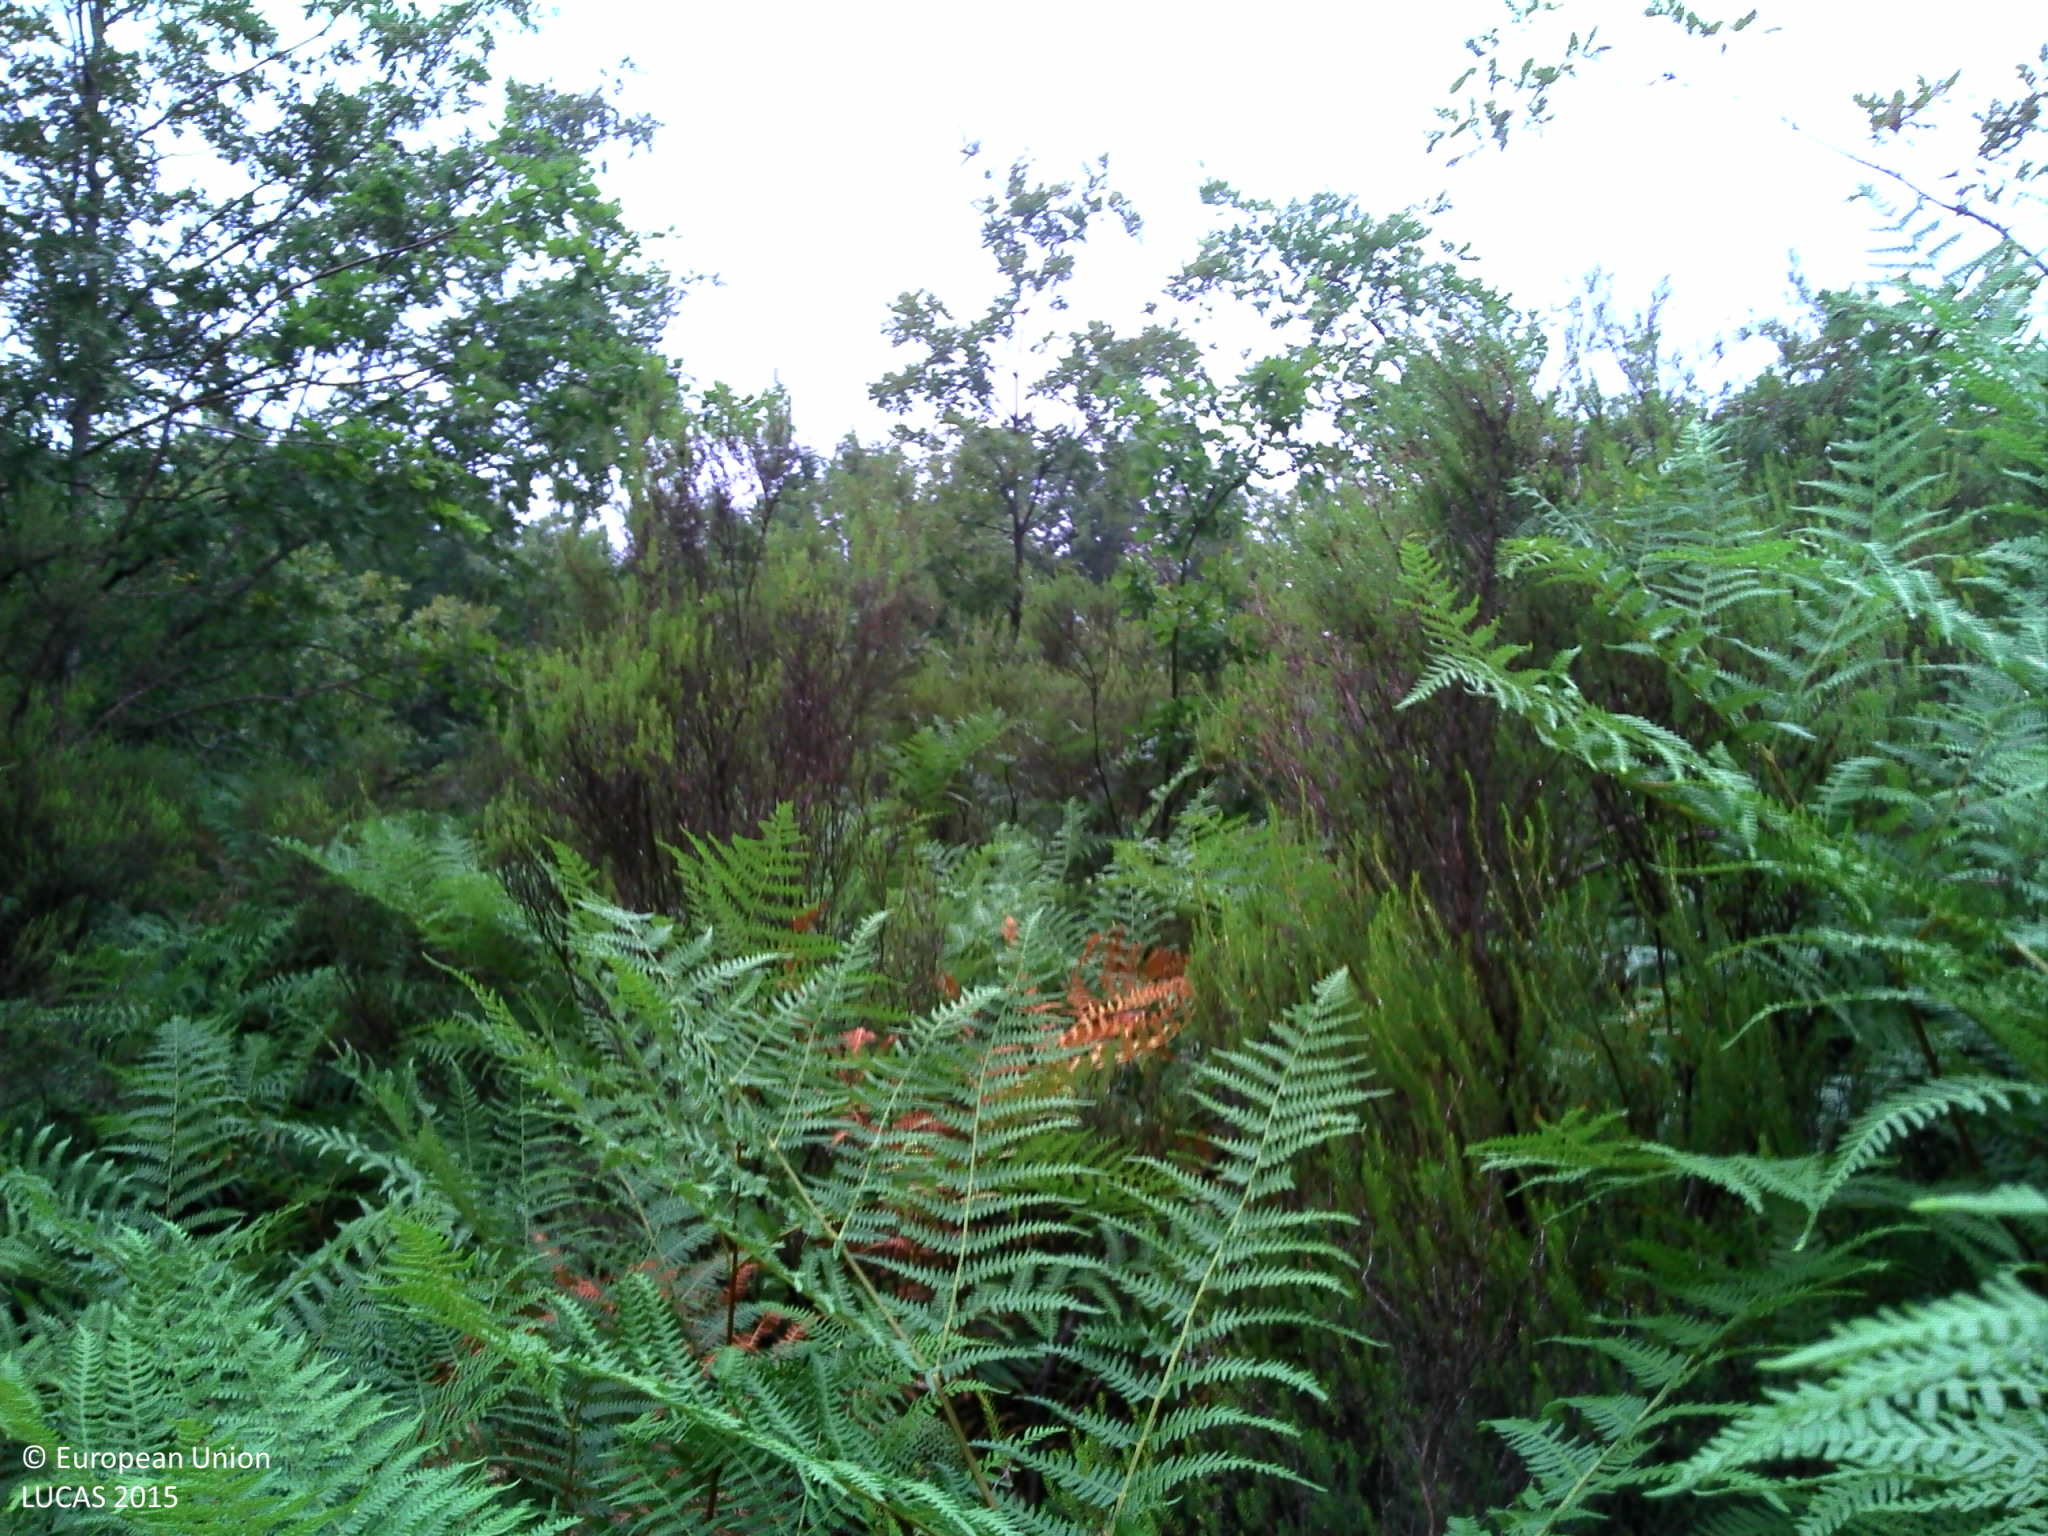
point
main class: Woodland
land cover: Broadleaved woodland
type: thermophilous deciduous forest
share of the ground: > 75 %
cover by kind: broadleaved forest trees 80 %, herbaceous plants 10 %, shrubs 5 %, lichens and mosses 5 %
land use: Forestry
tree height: < 5 m
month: August
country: FR
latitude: 44.5995
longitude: 0.8602
